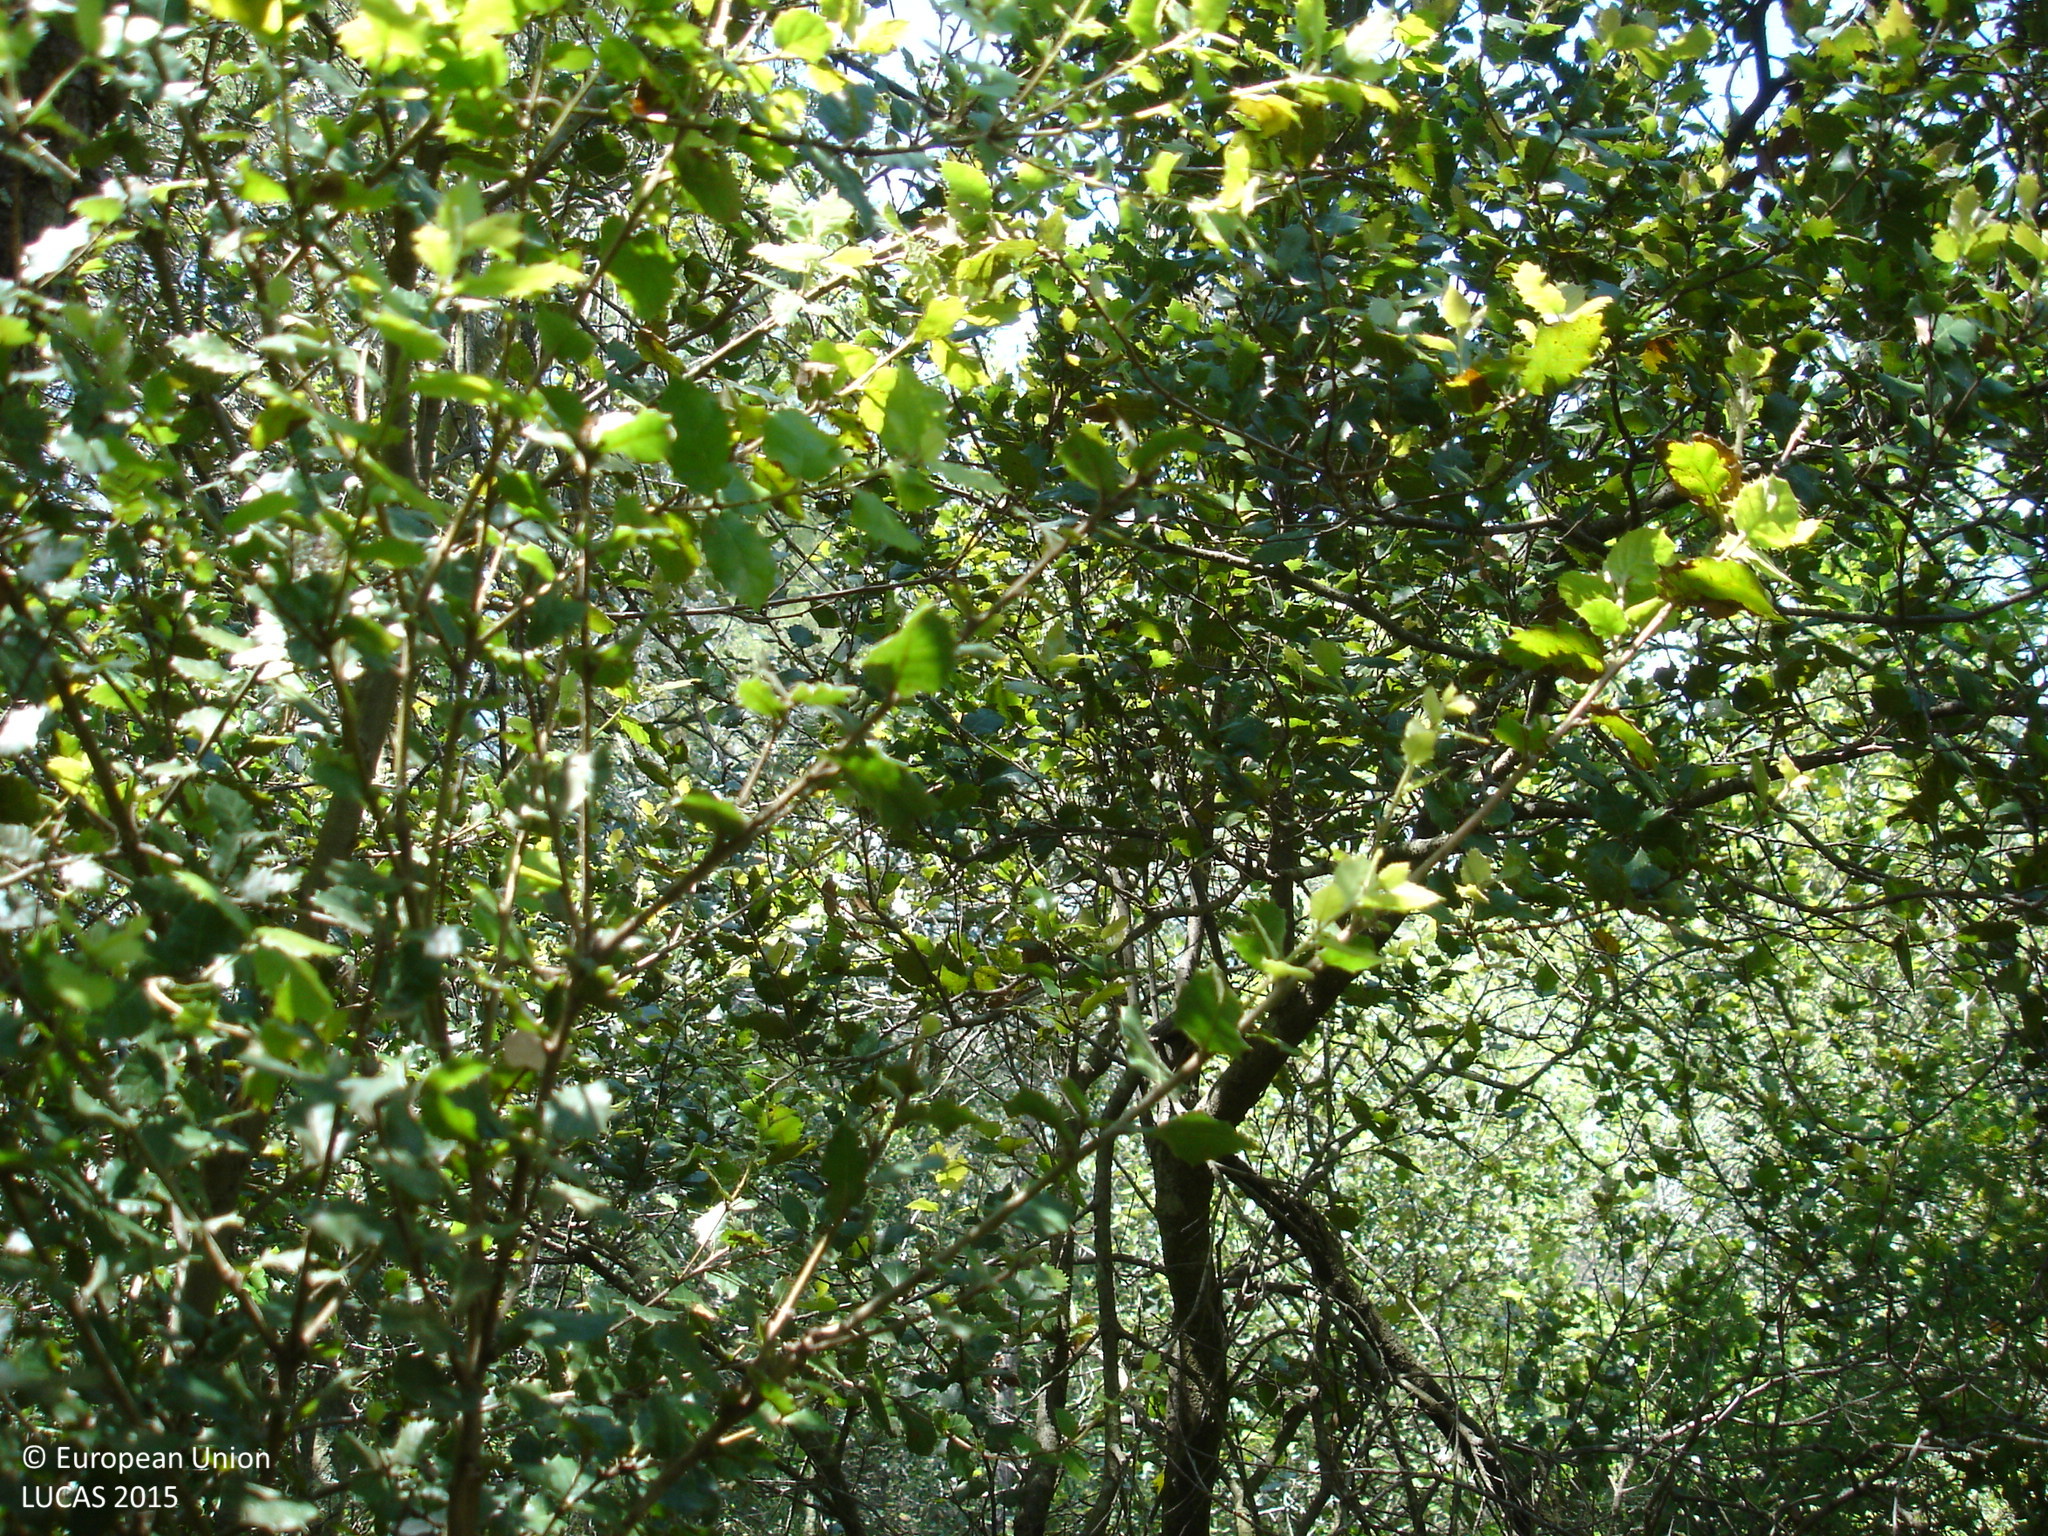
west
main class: Woodland
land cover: Other mixed woodland
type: coniferous forest of the mediterranean region
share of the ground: > 75 %
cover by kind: coniferous forest trees 50 %, broadleaved forest trees 40 %, shrubs 10 %
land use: Forestry
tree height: > 5 m
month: May
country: ES
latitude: 42.1208
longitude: 2.9874
